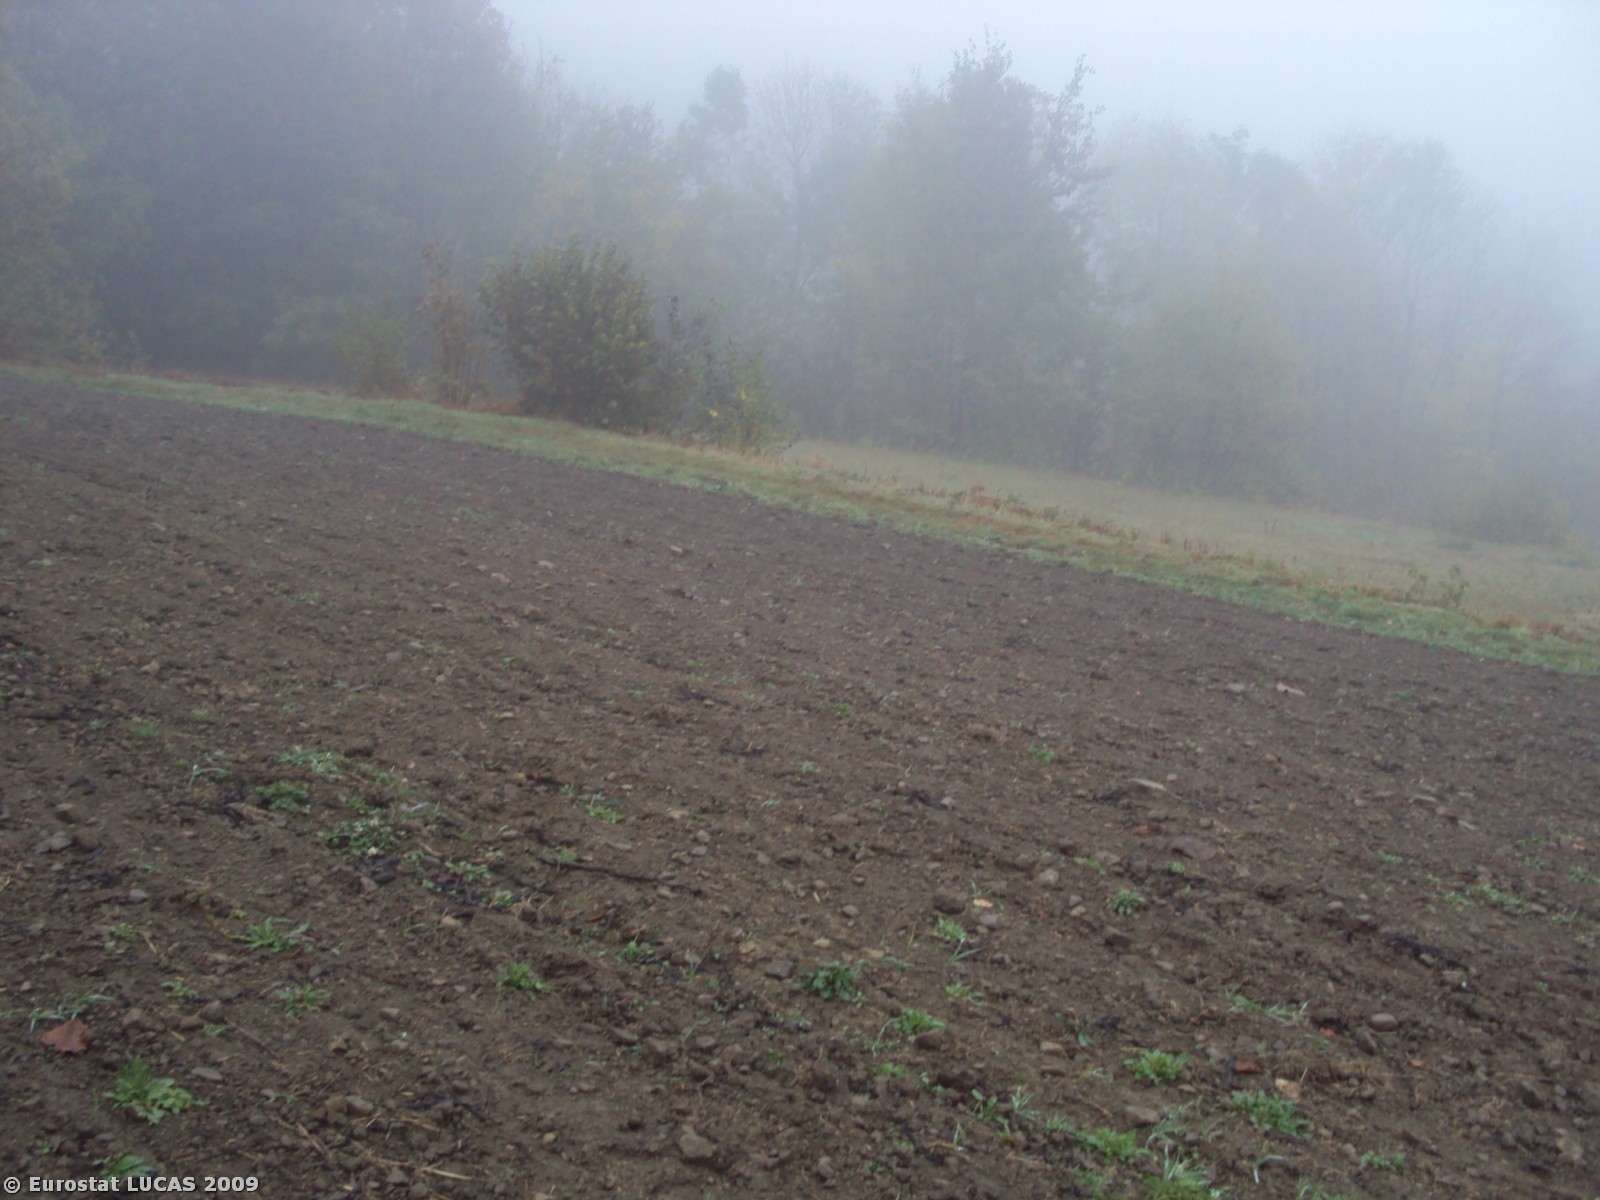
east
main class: Cropland
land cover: Common wheat
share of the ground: < 10 %
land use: Agriculture (excluding fallow land and kitchen gardens)
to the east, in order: Common wheat; Rye; Coniferous woodland; Grassland without tree/shrub cover; Artificial constructions in urban areas
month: September
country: PL
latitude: 49.7678
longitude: 19.9306
